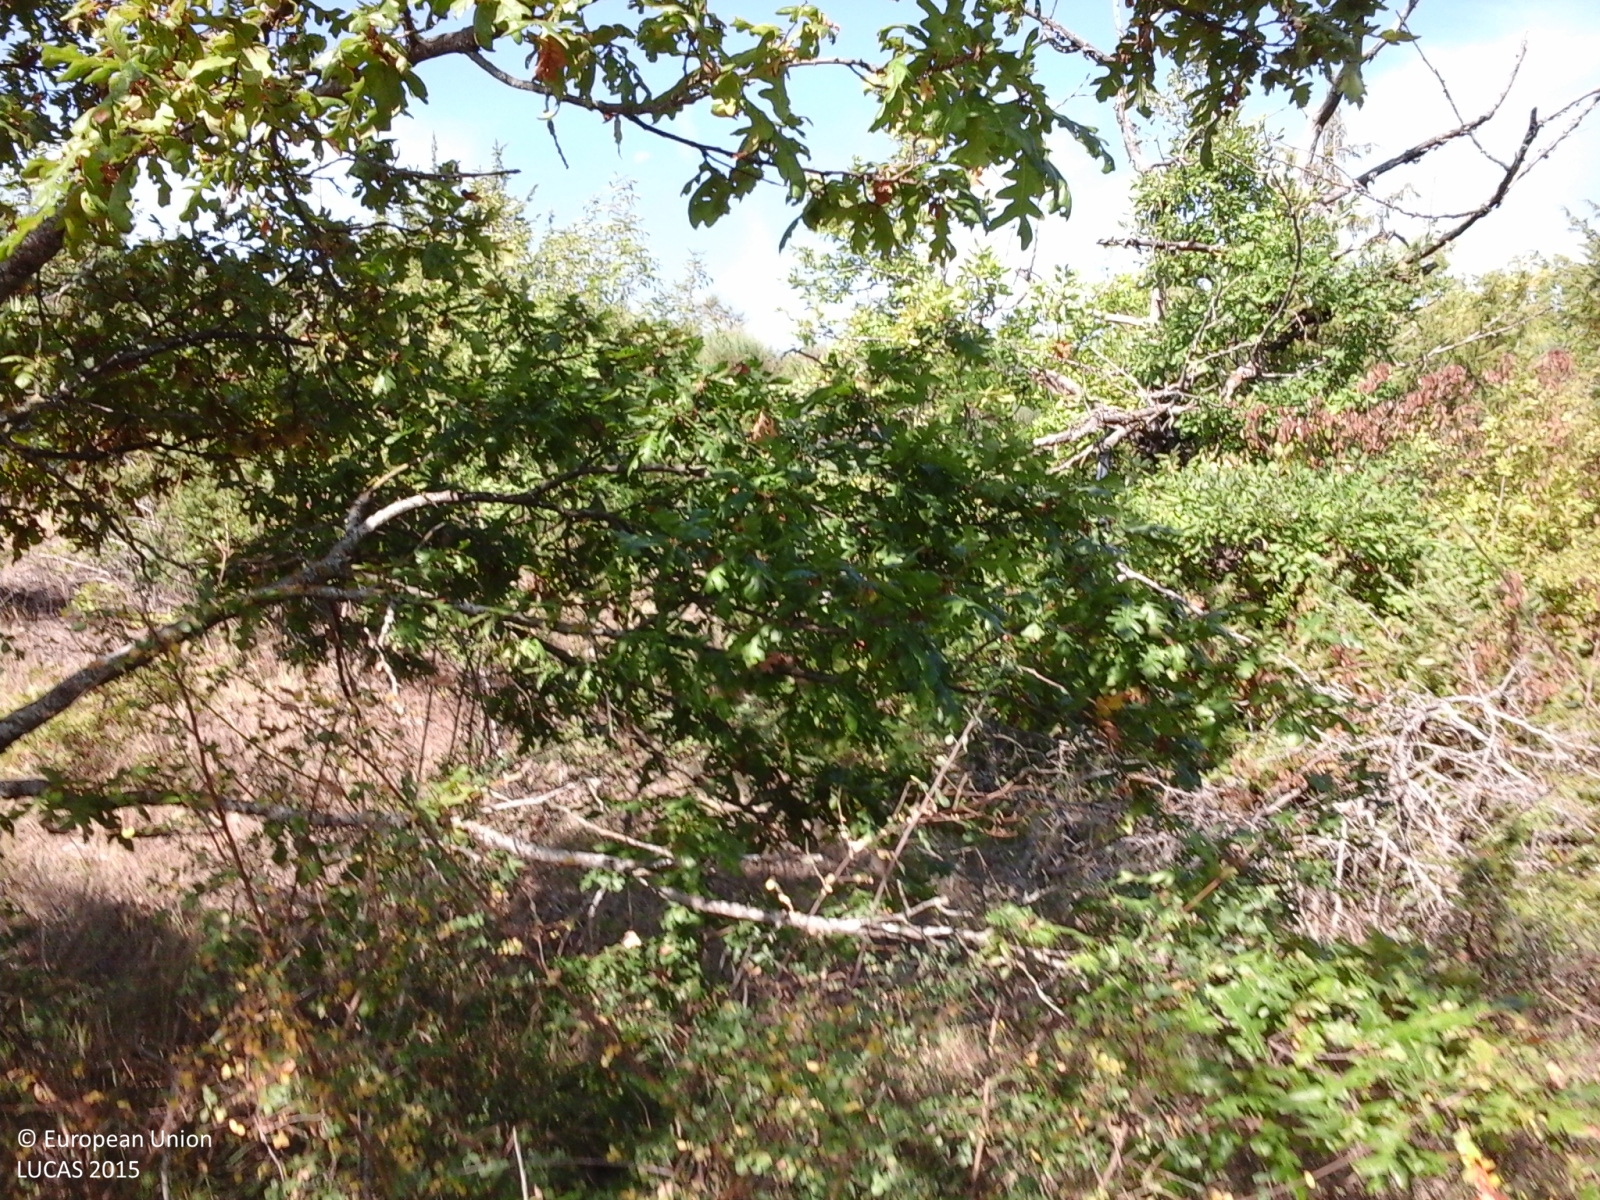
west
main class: Woodland
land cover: Broadleaved woodland
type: thermophilous deciduous forest
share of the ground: > 75 %
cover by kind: broadleaved forest trees 45 %, shrubs 30 %, herbaceous plants 25 %
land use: Semi-natural and natural areas not in use
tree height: > 5 m
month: September
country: IT
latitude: 41.6434
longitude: 14.2231
